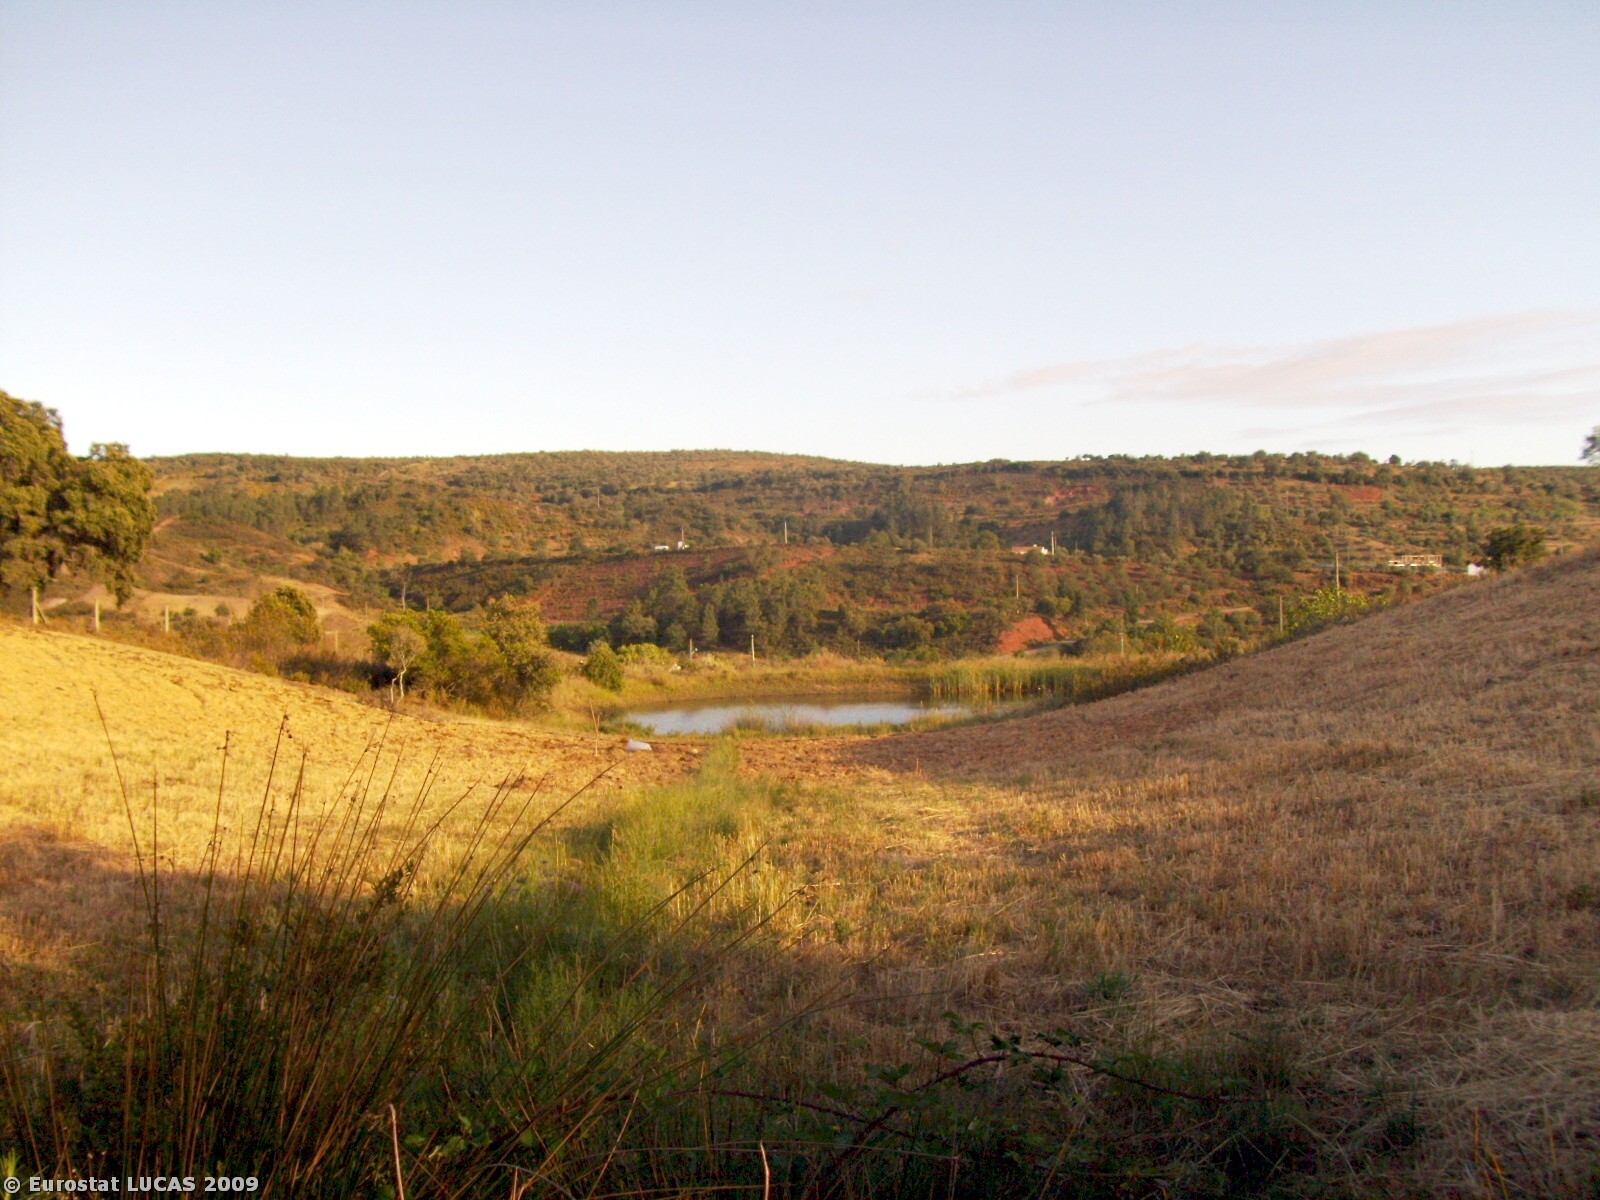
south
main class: Shrubland
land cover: Shrubland without tree cover
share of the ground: > 75 %
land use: Unused
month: May
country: PT
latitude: 37.2566
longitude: -8.1836
